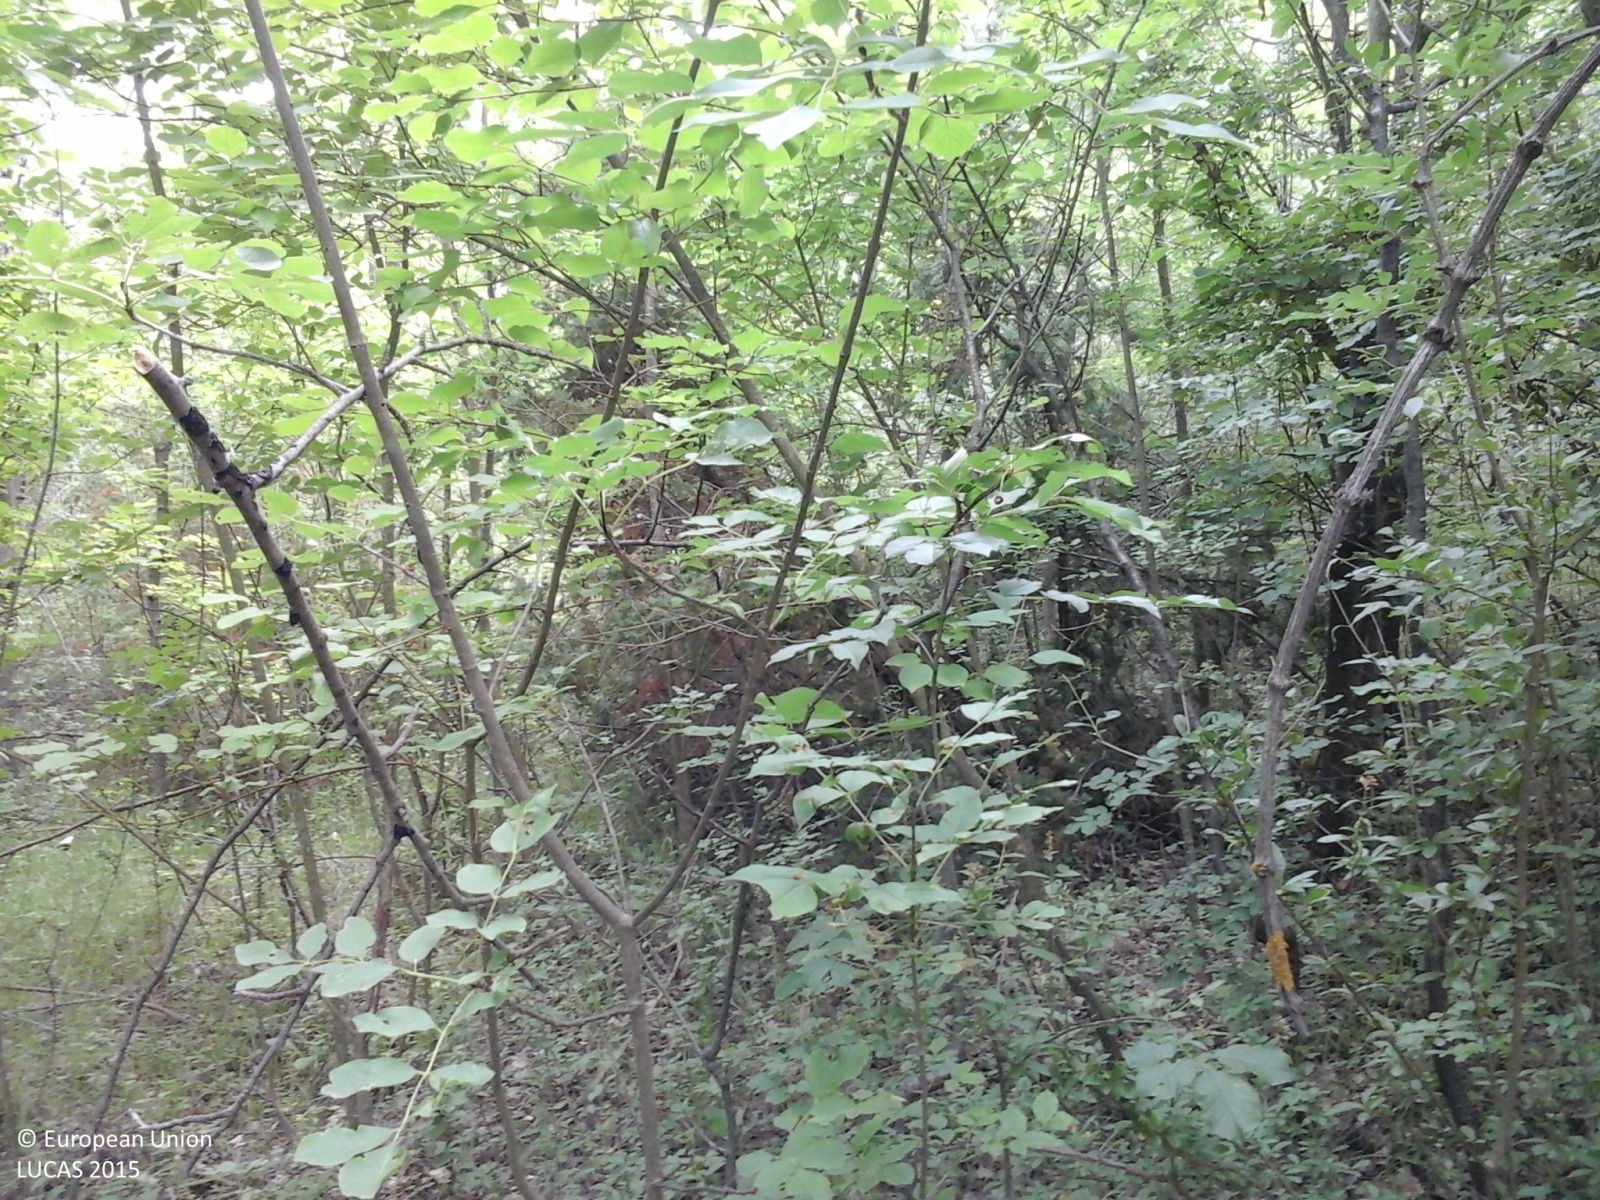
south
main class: Woodland
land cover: Broadleaved woodland
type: thermophilous deciduous forest
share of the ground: > 75 %
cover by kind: broadleaved forest trees 80 %, shrubs 10 %, herbaceous plants 10 %
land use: Semi-natural and natural areas not in use
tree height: > 5 m
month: June
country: IT
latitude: 44.6280
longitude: 8.4780
